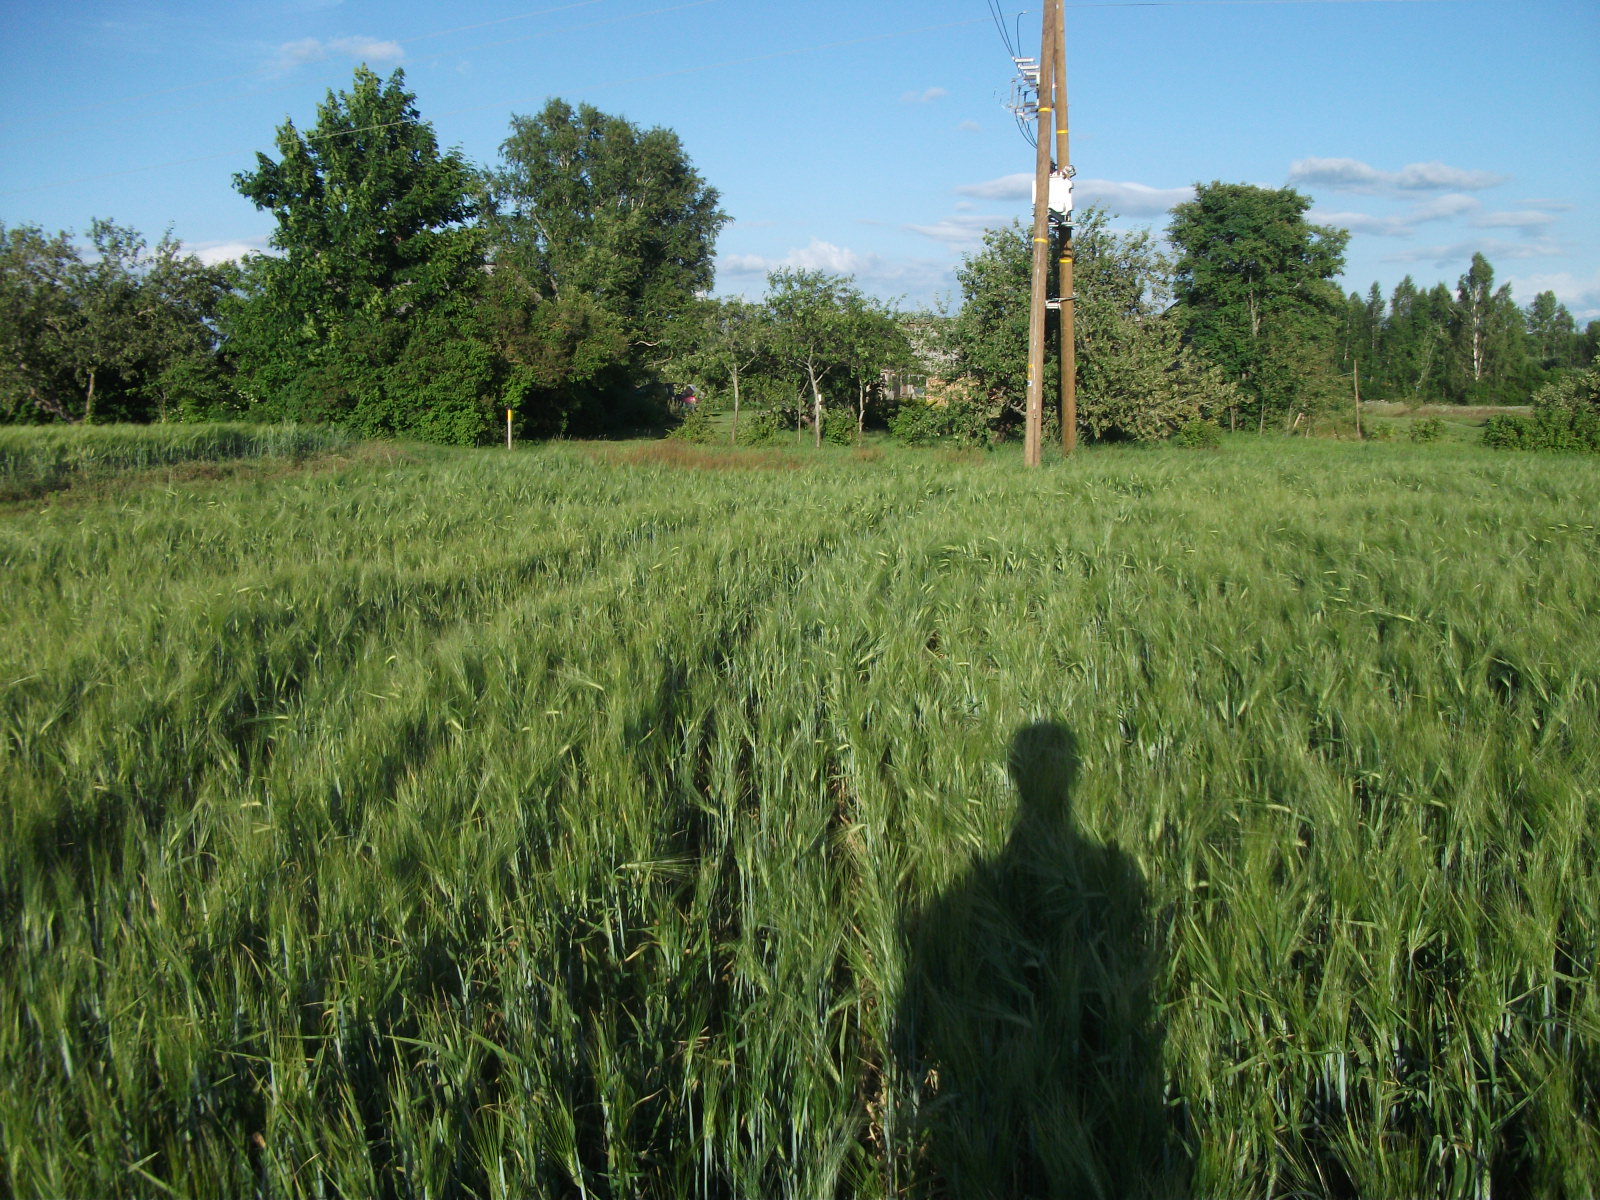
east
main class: Cropland
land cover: Barley
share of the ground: > 75 %
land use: Agriculture (excluding fallow land and kitchen gardens)
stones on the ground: < 10 %
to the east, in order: Barley; Electric lines; Barley; Apple fruit; Grassland without tree/shrub cover; Artificial constructions in urban areas; Grassland without tree/shrub cover; Abandoned hedges; Ditches and canals; Abandoned hedges; Grassland without tree/shrub cover
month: July
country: LV
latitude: 56.8102
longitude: 26.5771
